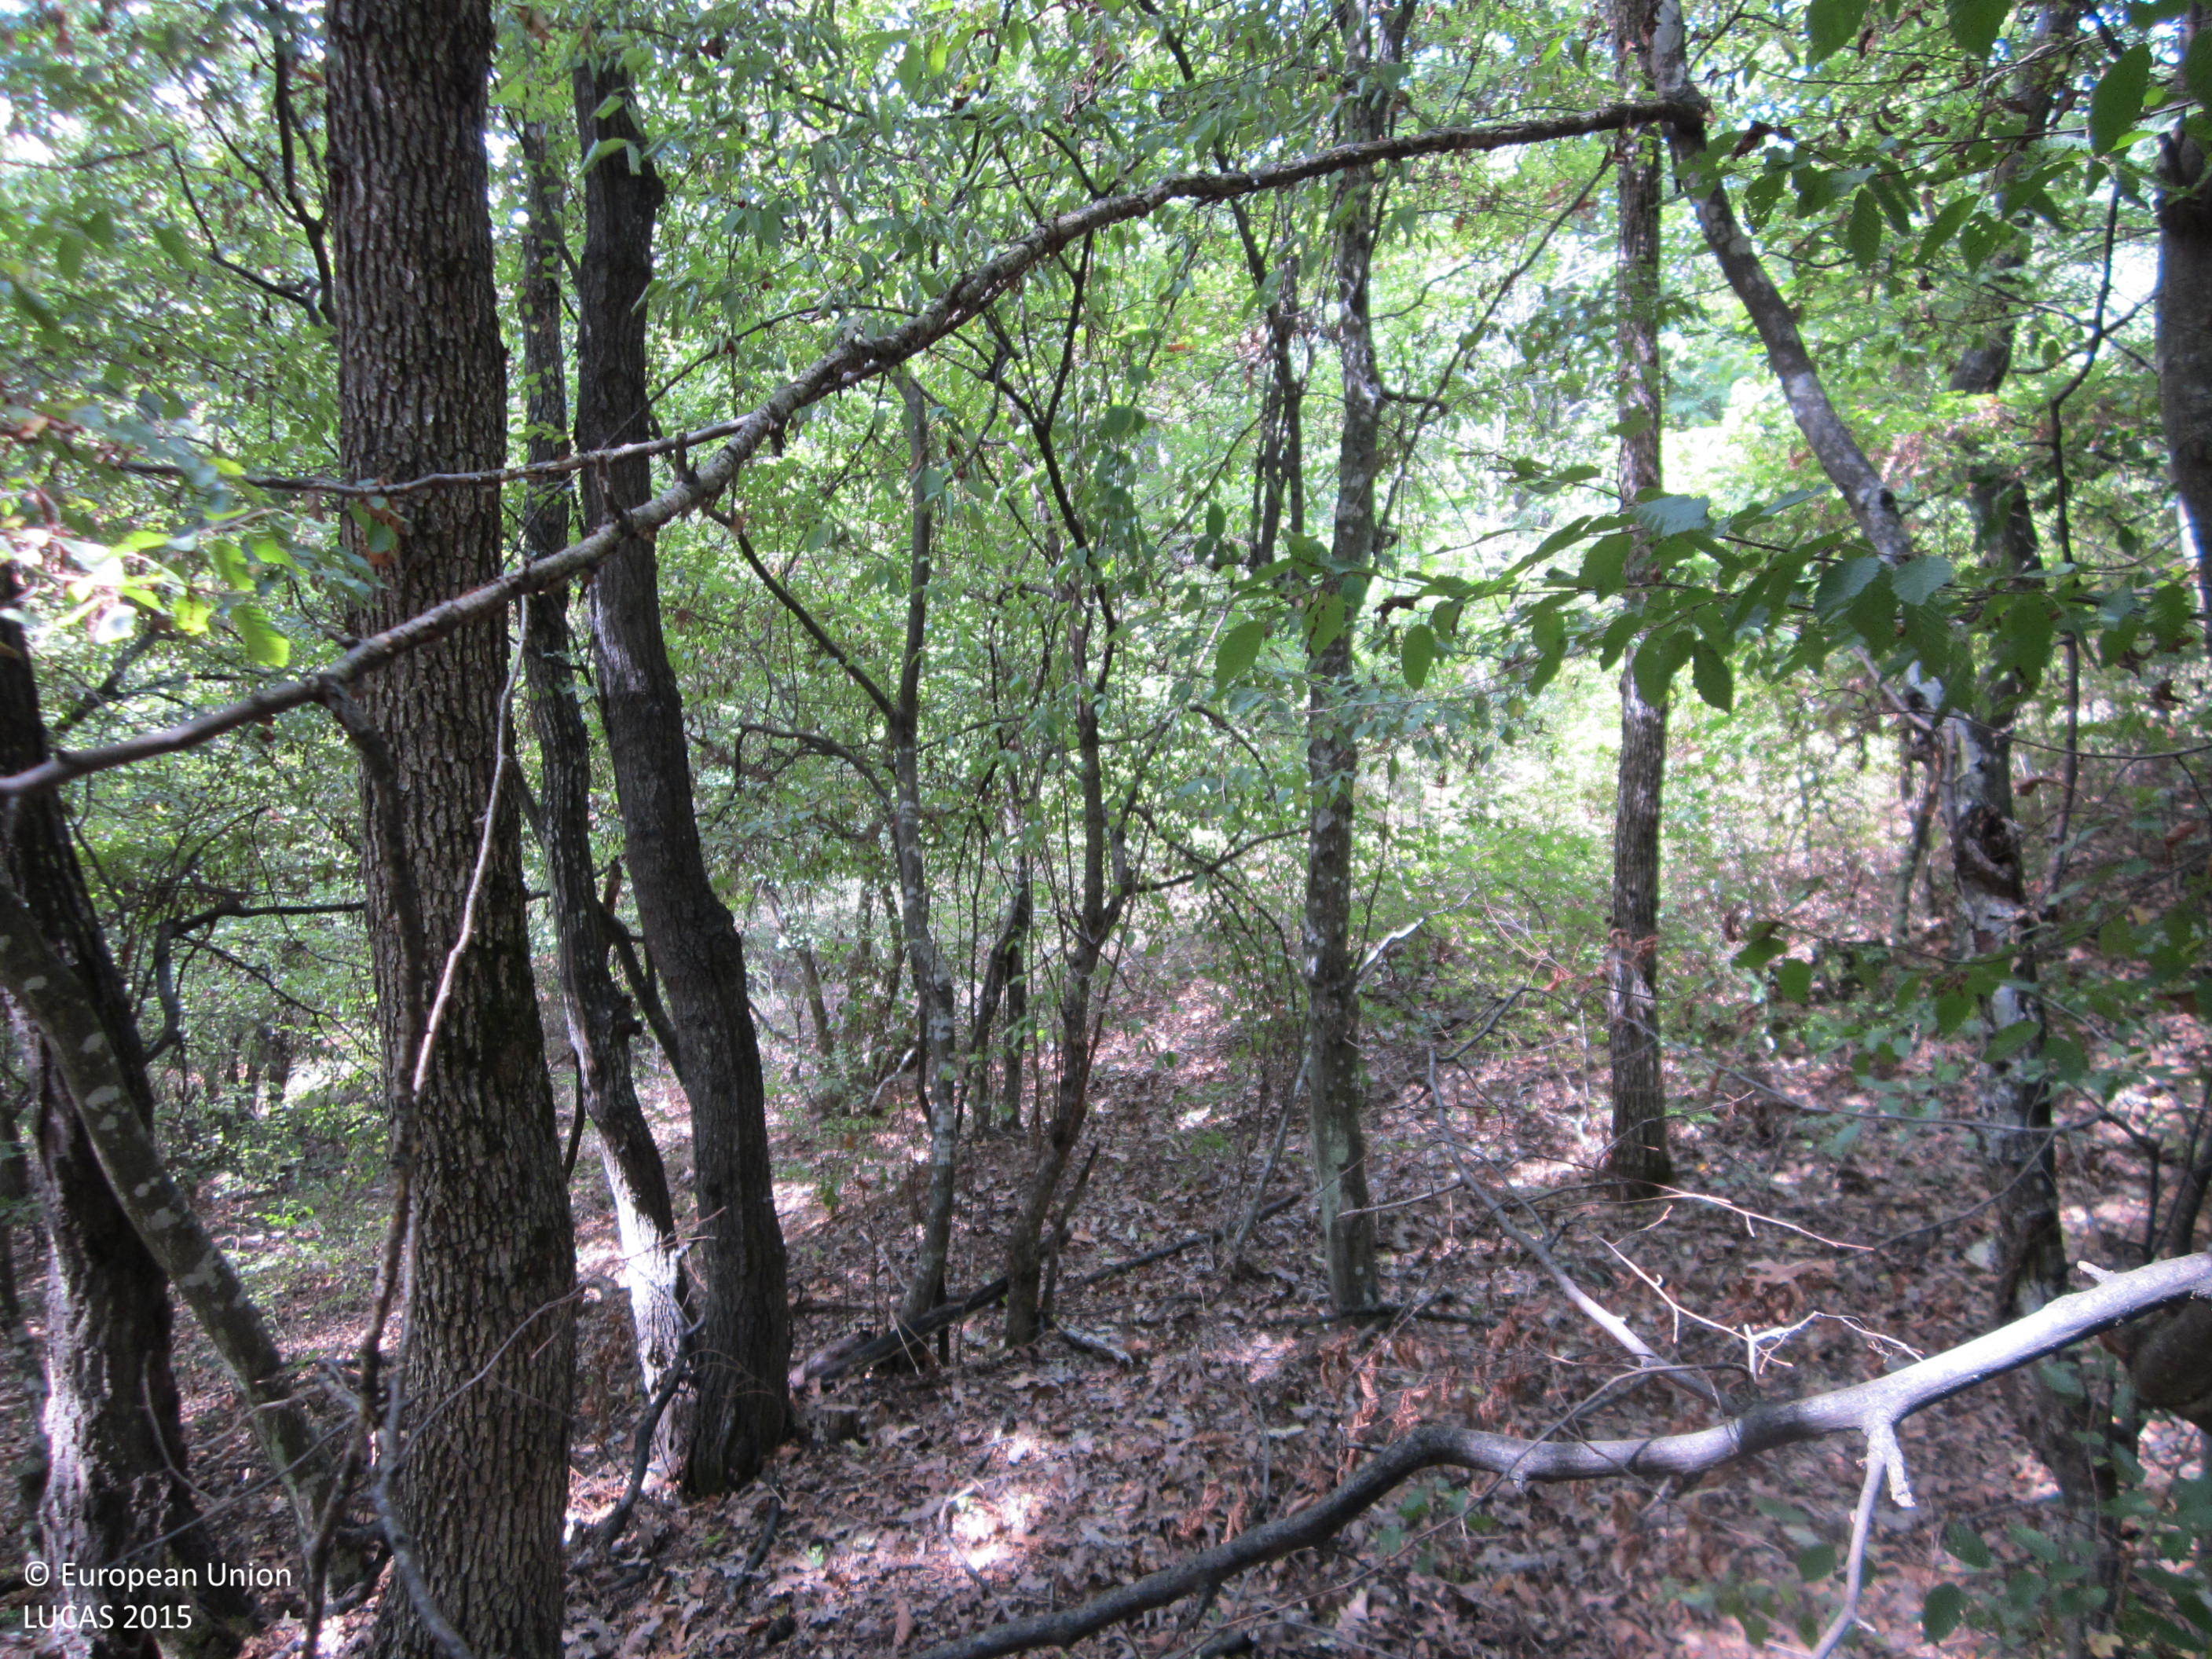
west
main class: Woodland
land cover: Broadleaved woodland
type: mesophytic deciduous forest
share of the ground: > 75 %
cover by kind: broadleaved forest trees 90 %, shrubs 5 %, unconsolidated bare surface 5 %
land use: Forestry
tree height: > 5 m
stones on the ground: < 10 %
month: September
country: BG
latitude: 42.8042
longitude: 27.1209
